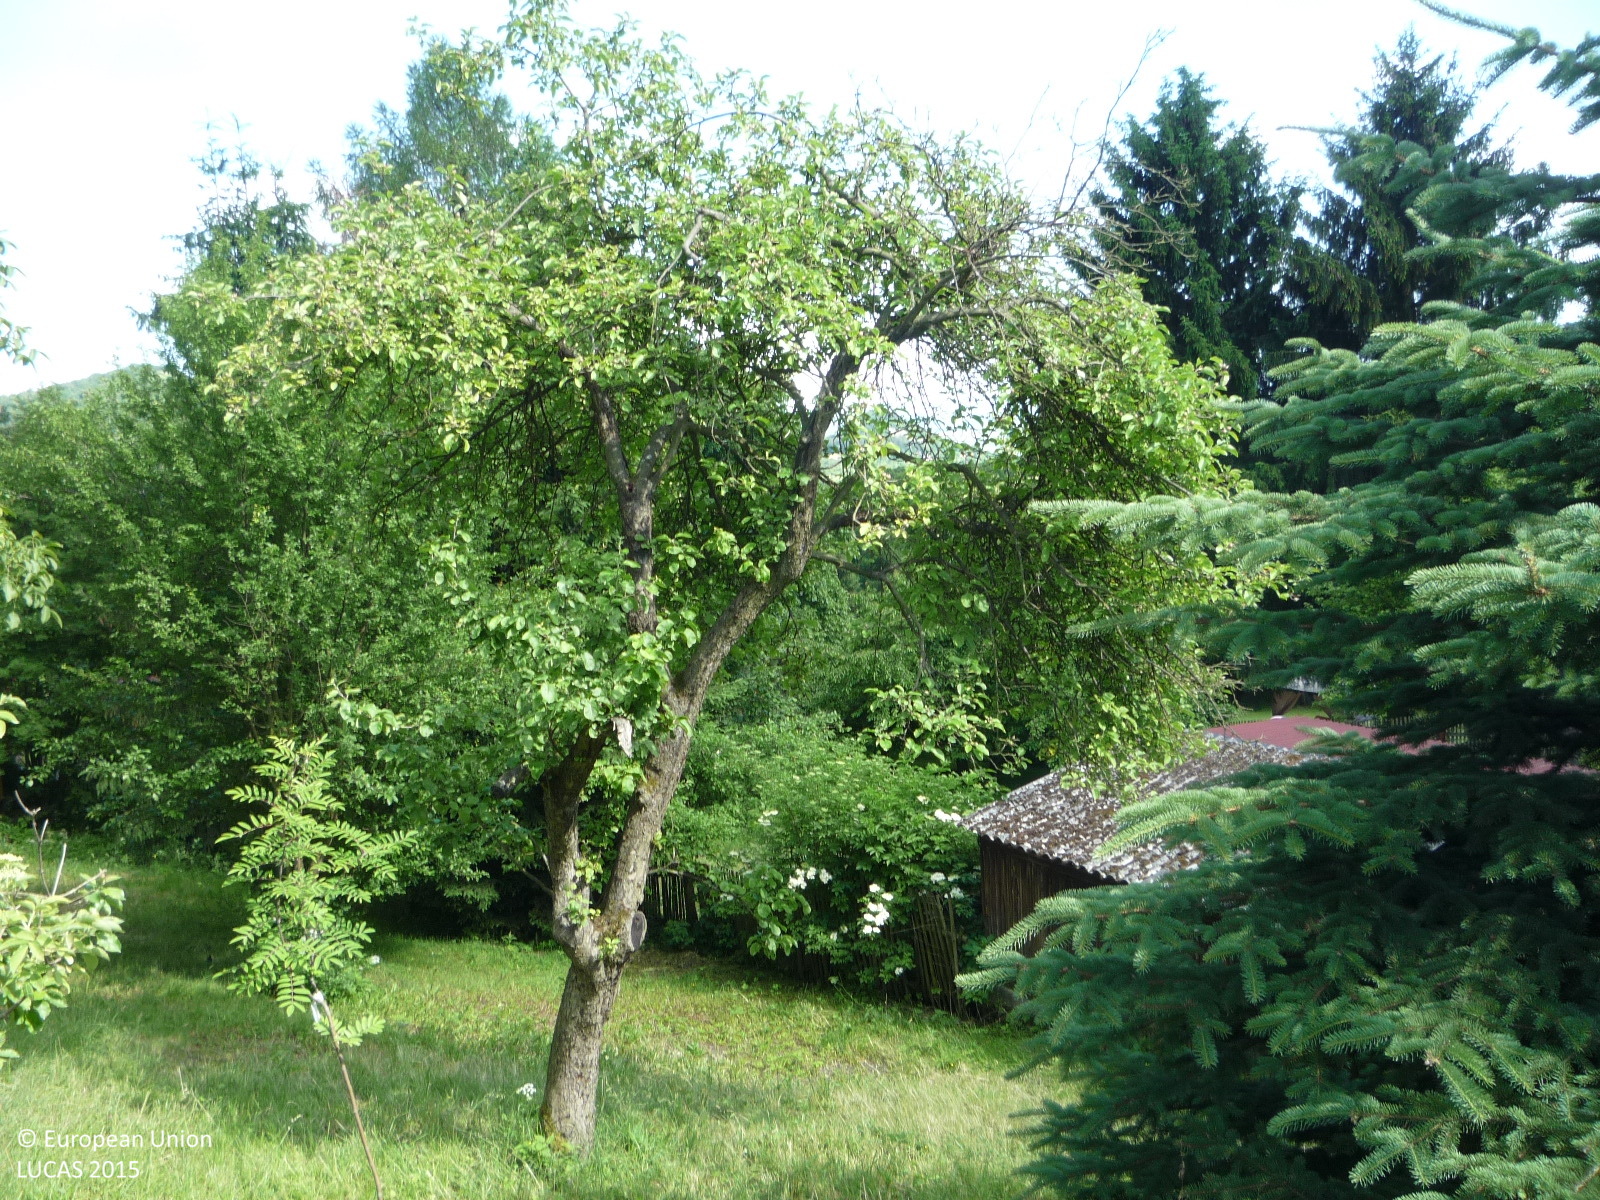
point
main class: Cropland
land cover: Apple fruit
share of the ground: 25 - 50 %
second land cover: Grassland without tree/shrub cover
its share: 50 - 75 %
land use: Kitchen garden
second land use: Residential
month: June
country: CZ
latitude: 50.4964
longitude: 13.8776
